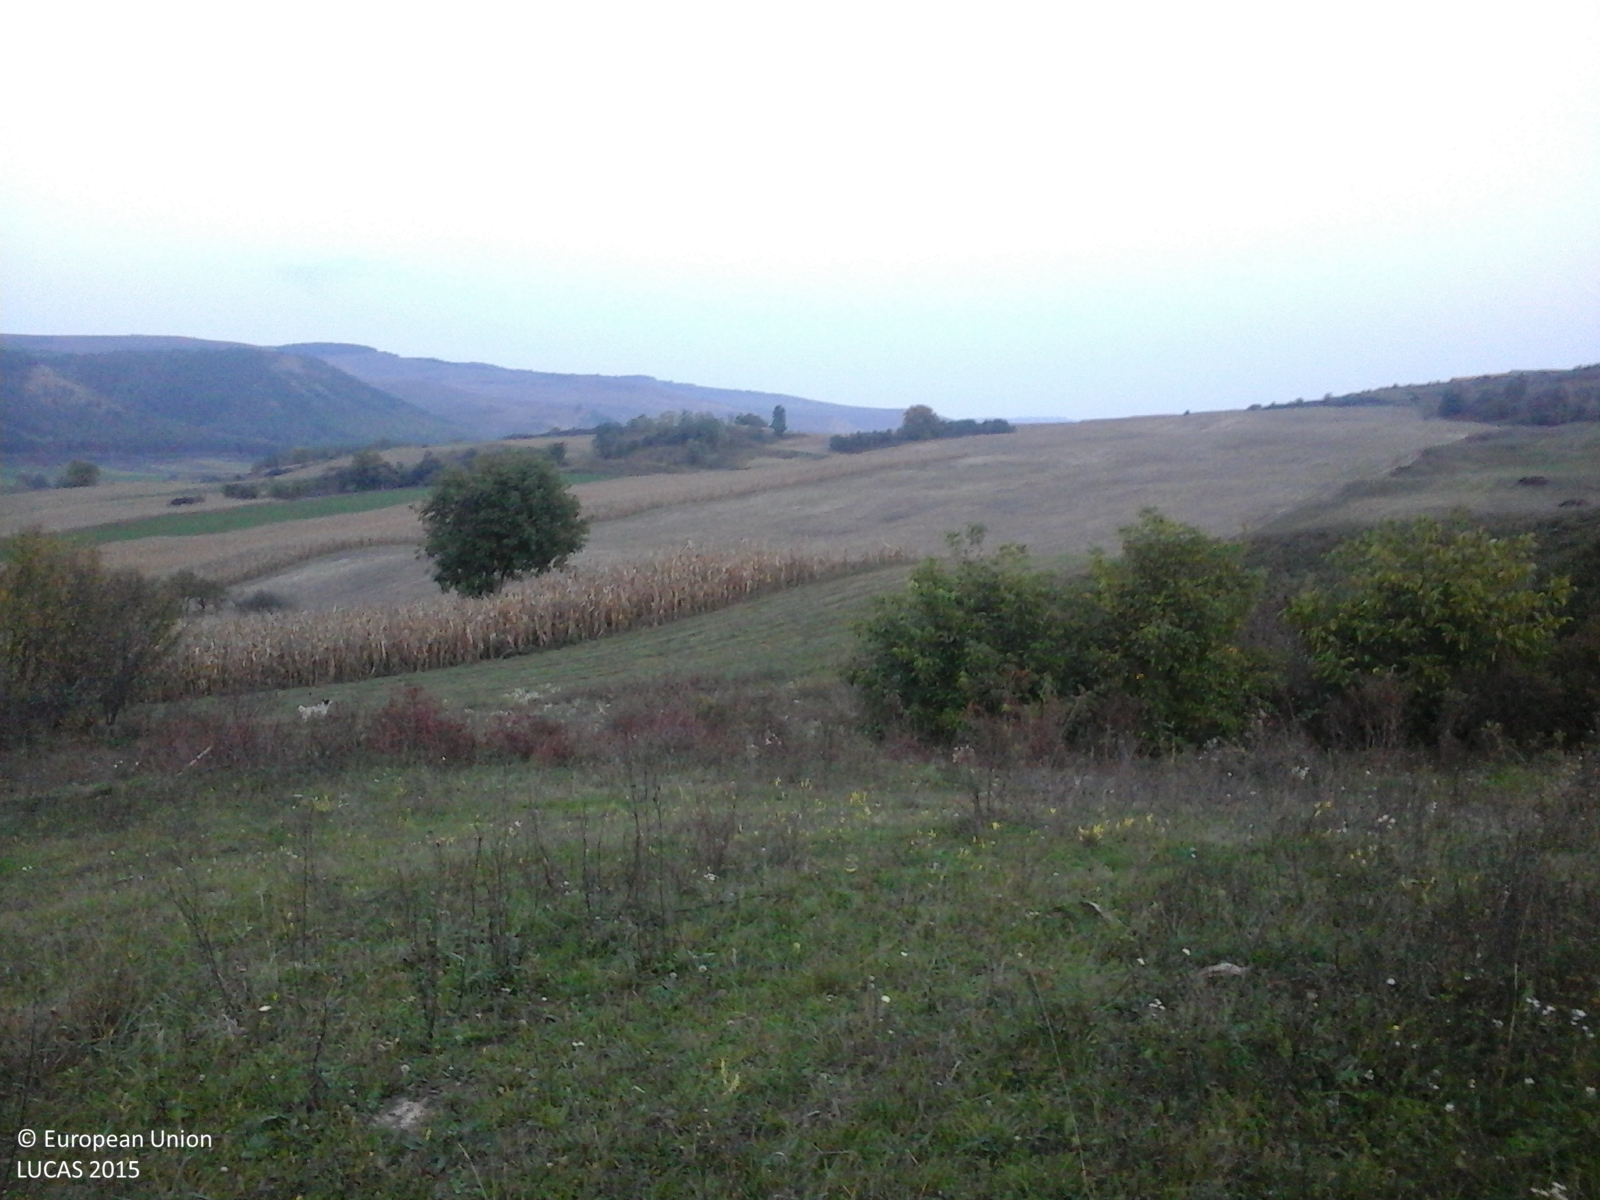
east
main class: Cropland
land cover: Maize
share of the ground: > 75 %
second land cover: Spontaneously vegetated surfaces
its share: > 75 %
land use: Agriculture (excluding fallow land and kitchen gardens)
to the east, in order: Maize; Spontaneously vegetated surfaces; Grassland without tree/shrub cover; Grassland with sparse tree/shrub cover; Spontaneously vegetated surfaces; Other leguminous and mixtures for fodder; Maize; Grassland without tree/shrub cover; Single bushes/trees; Grassland without tree/shrub cover; Abandoned hedges; Grassland without tree/shrub cover; Tracks; Spontaneously vegetated surfaces; Ditches and canals; Spontaneously vegetated surfaces; Maize
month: October
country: RO
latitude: 46.3363
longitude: 24.0158
